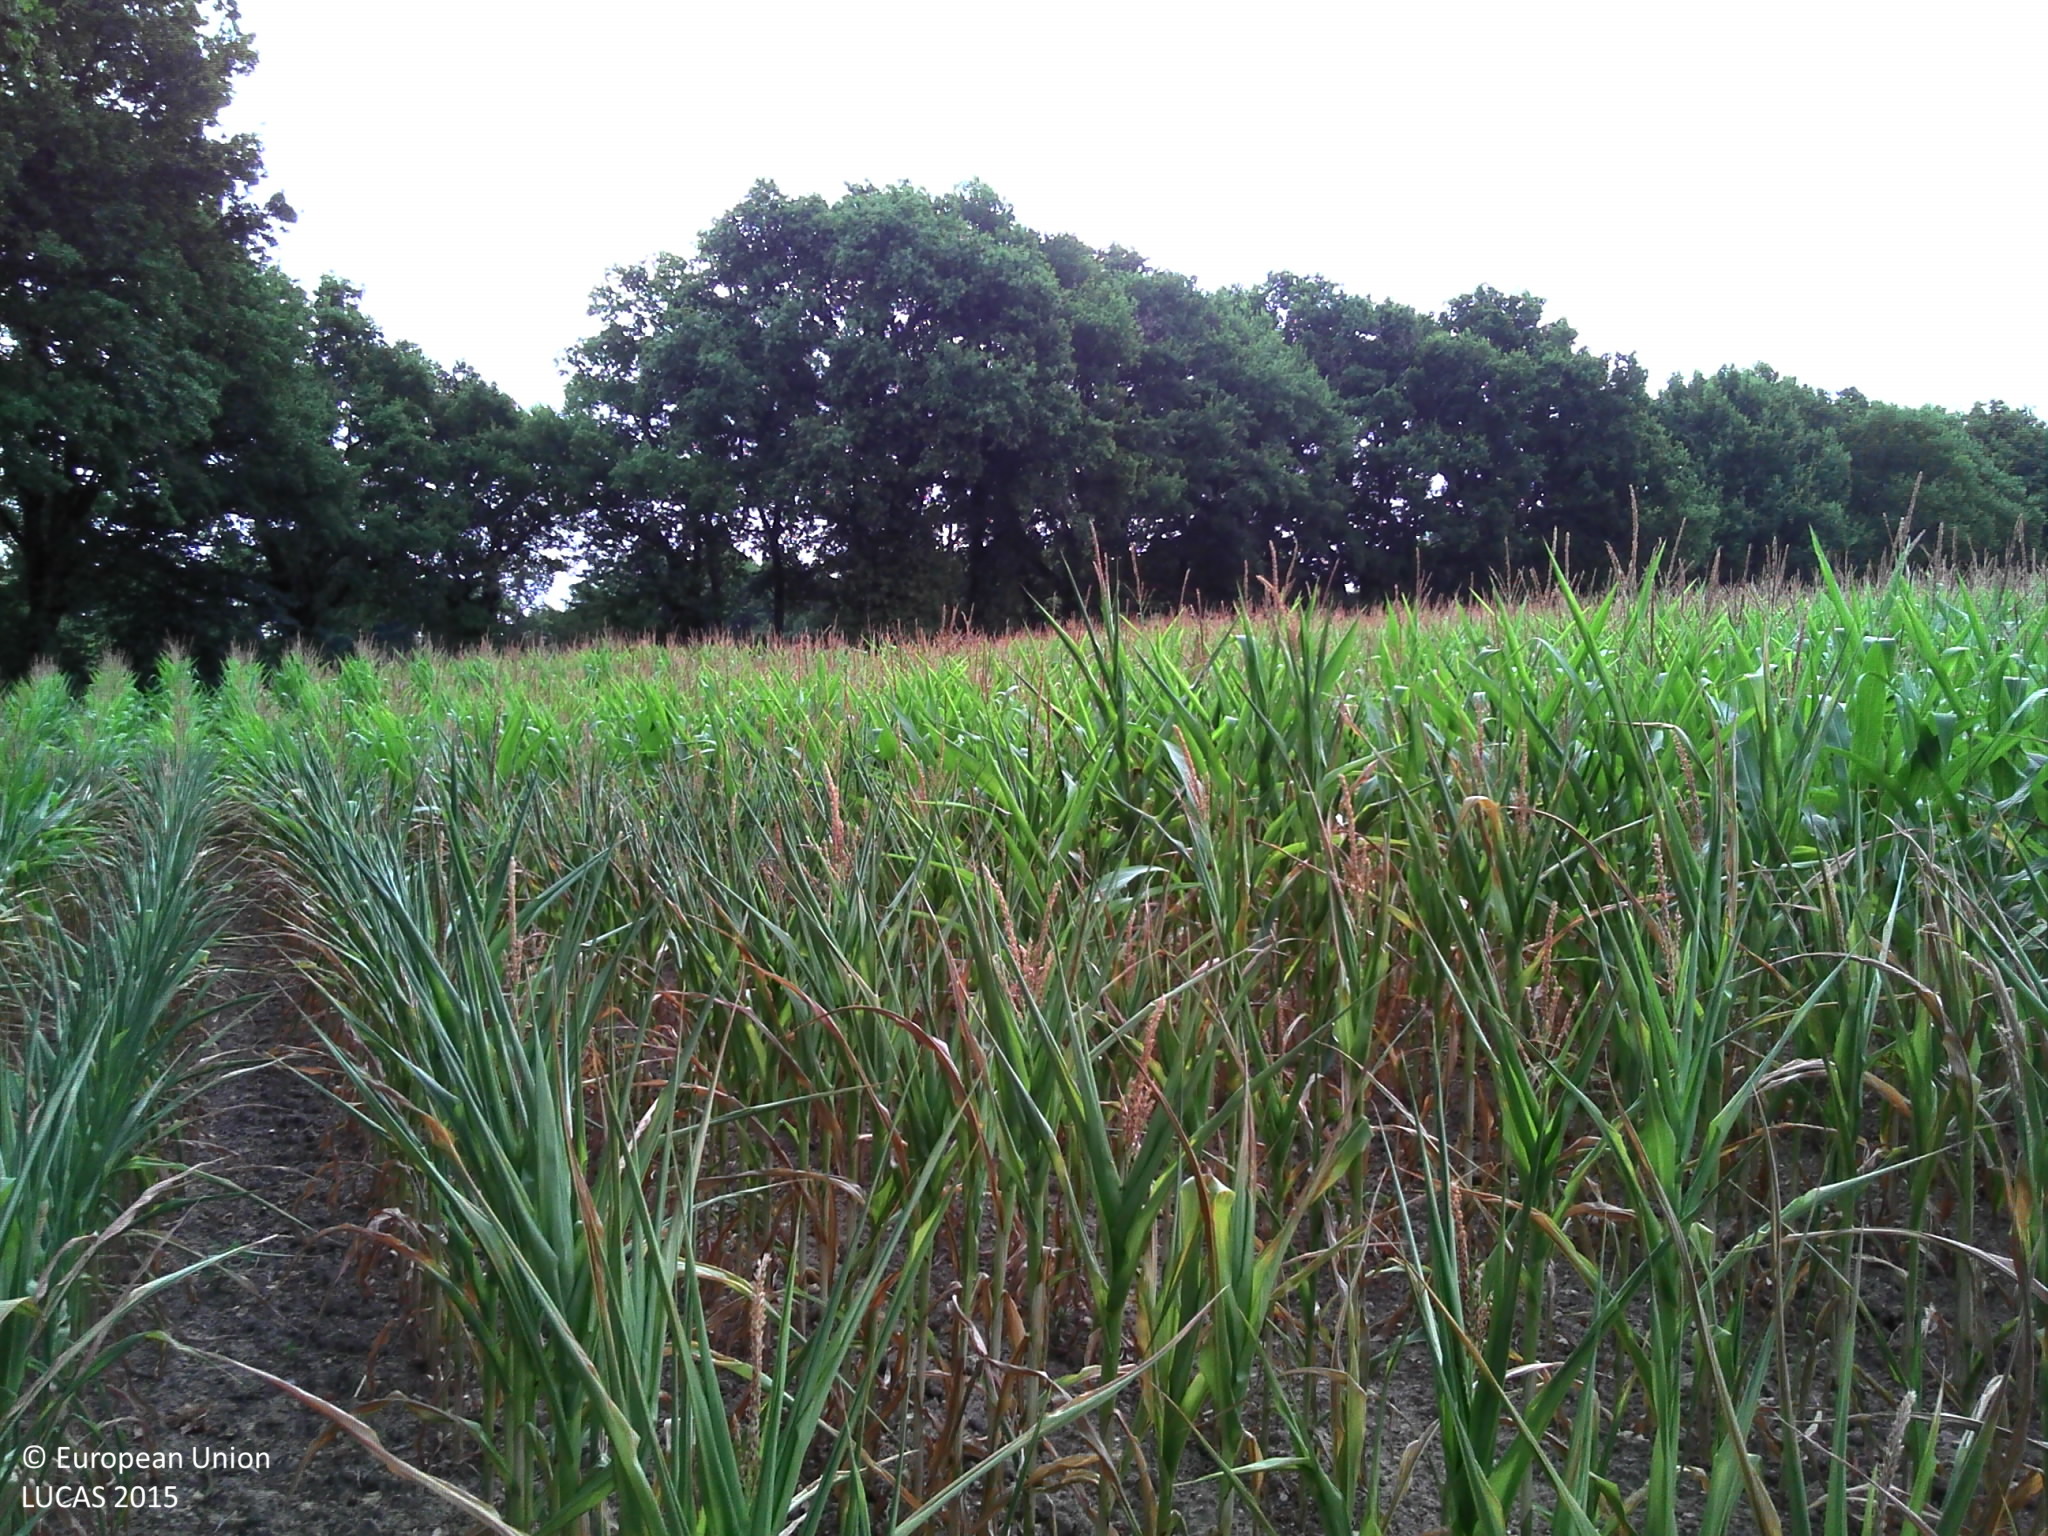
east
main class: Cropland
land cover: Maize
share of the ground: > 75 %
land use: Agriculture (excluding fallow land and kitchen gardens)
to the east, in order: Maize; Grass margins; Broadleaved woodland; Maize; Broadleaved woodland; Inland fresh water bodies; Broadleaved woodland; Fences; Grassland without tree/shrub cover
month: July
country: FR
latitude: 46.2718
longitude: 0.4980
